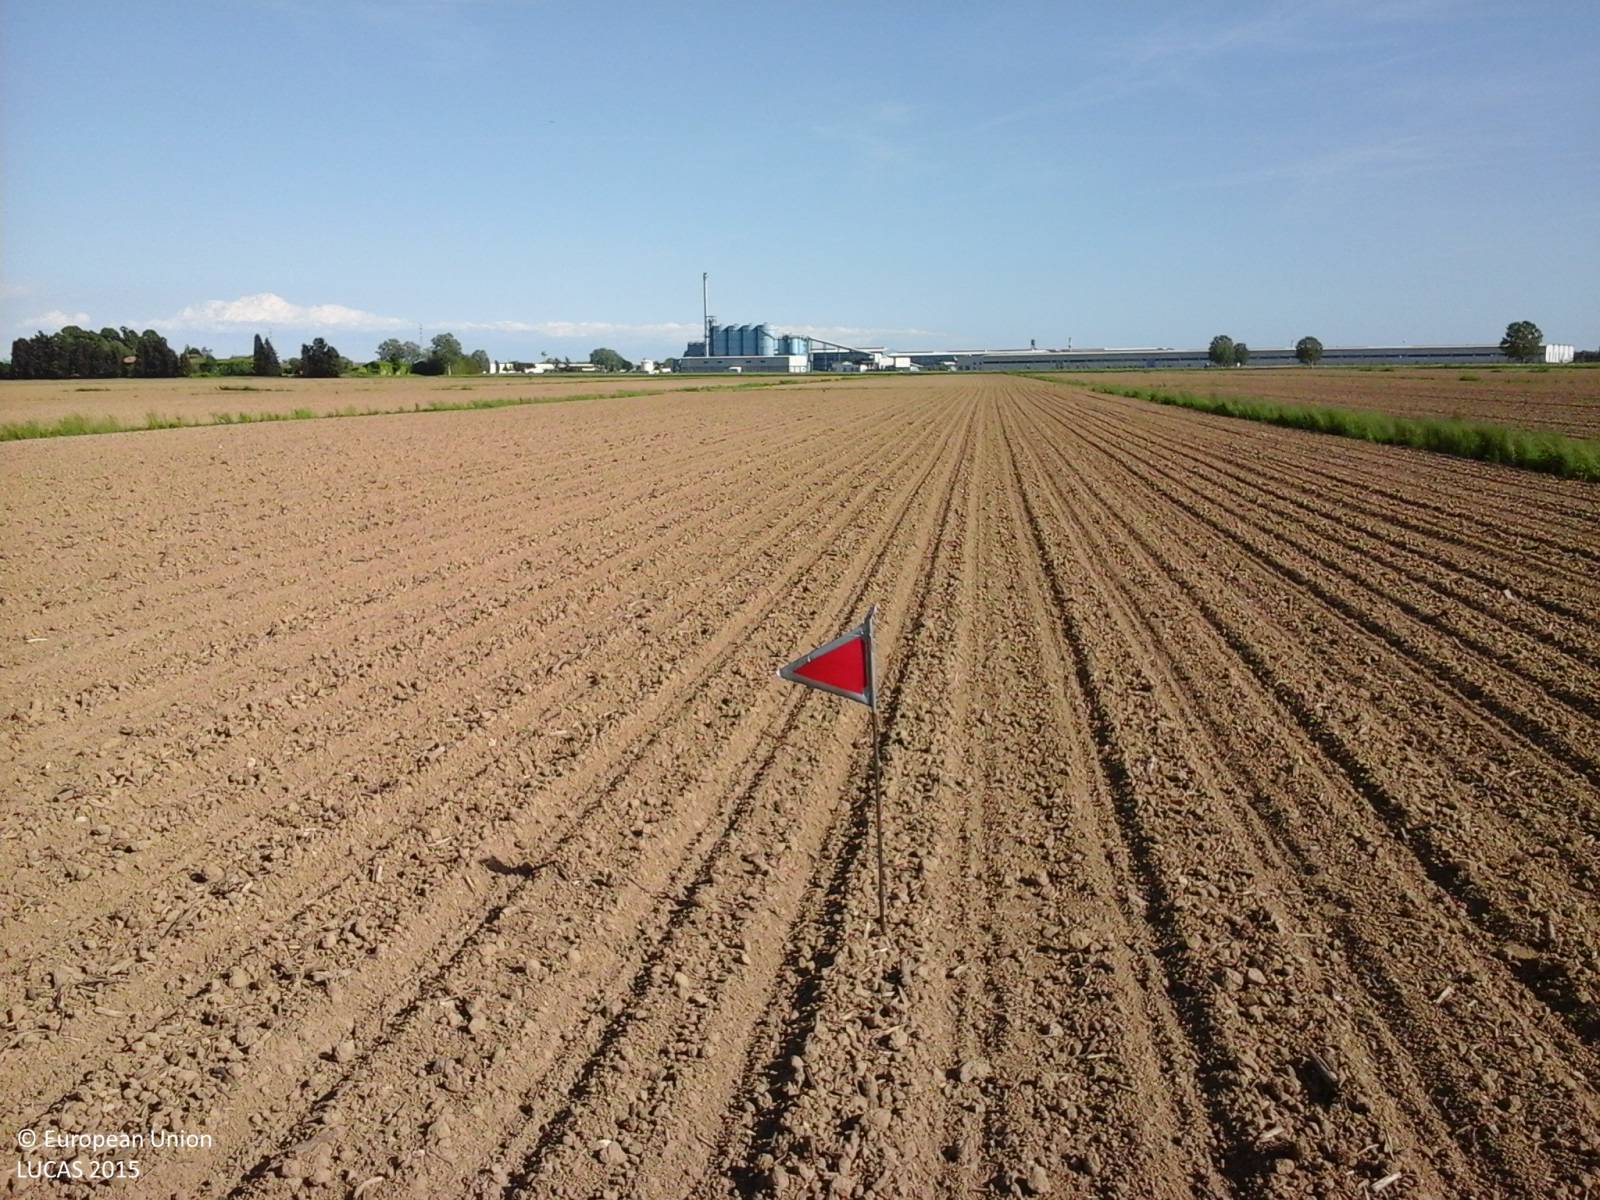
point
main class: Cropland
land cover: Soya
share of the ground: < 10 %
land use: Agriculture (excluding fallow land and kitchen gardens)
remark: Tilled/Sowed
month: May
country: IT
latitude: 45.7798
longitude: 13.2242
